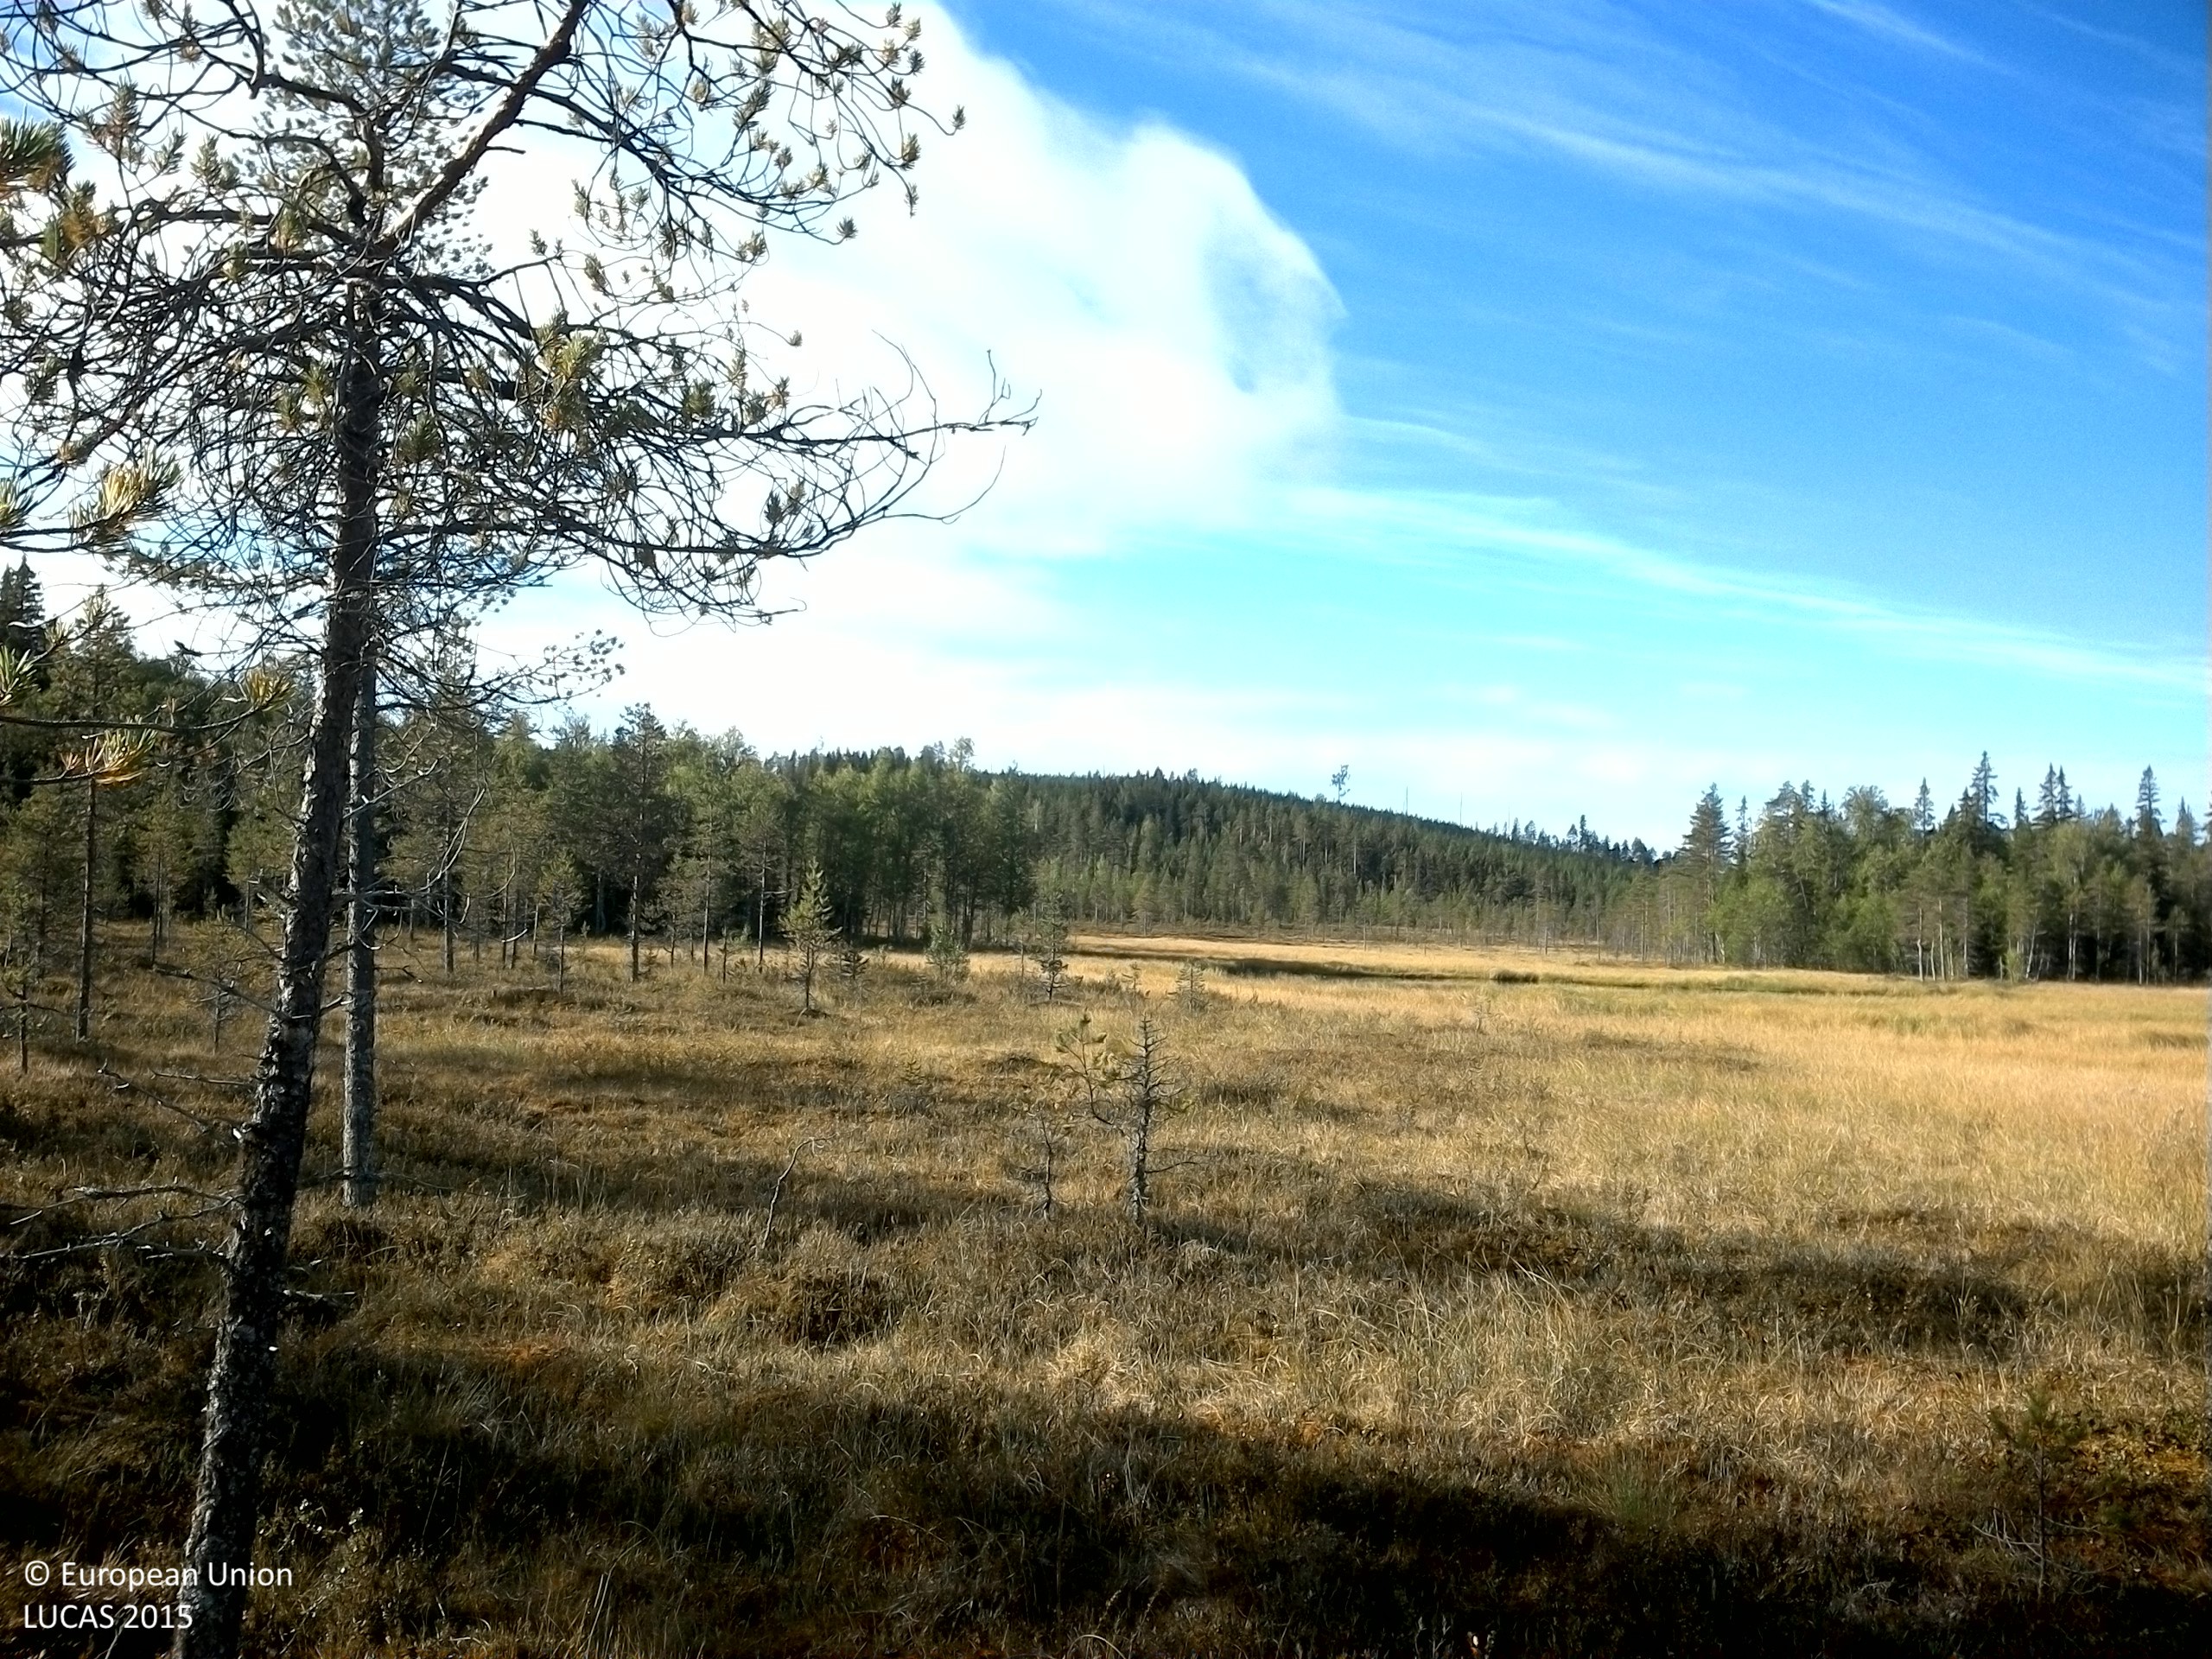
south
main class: Woodland
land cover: Pine dominated coniferous woodland
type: boreal forest
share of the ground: 10 - 25 %
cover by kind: lichens and mosses 50 %, shrubs 35 %, coniferous forest trees 15 %
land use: Semi-natural and natural areas not in use
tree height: < 5 m
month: September
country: SE
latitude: 63.9785
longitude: 17.6322
